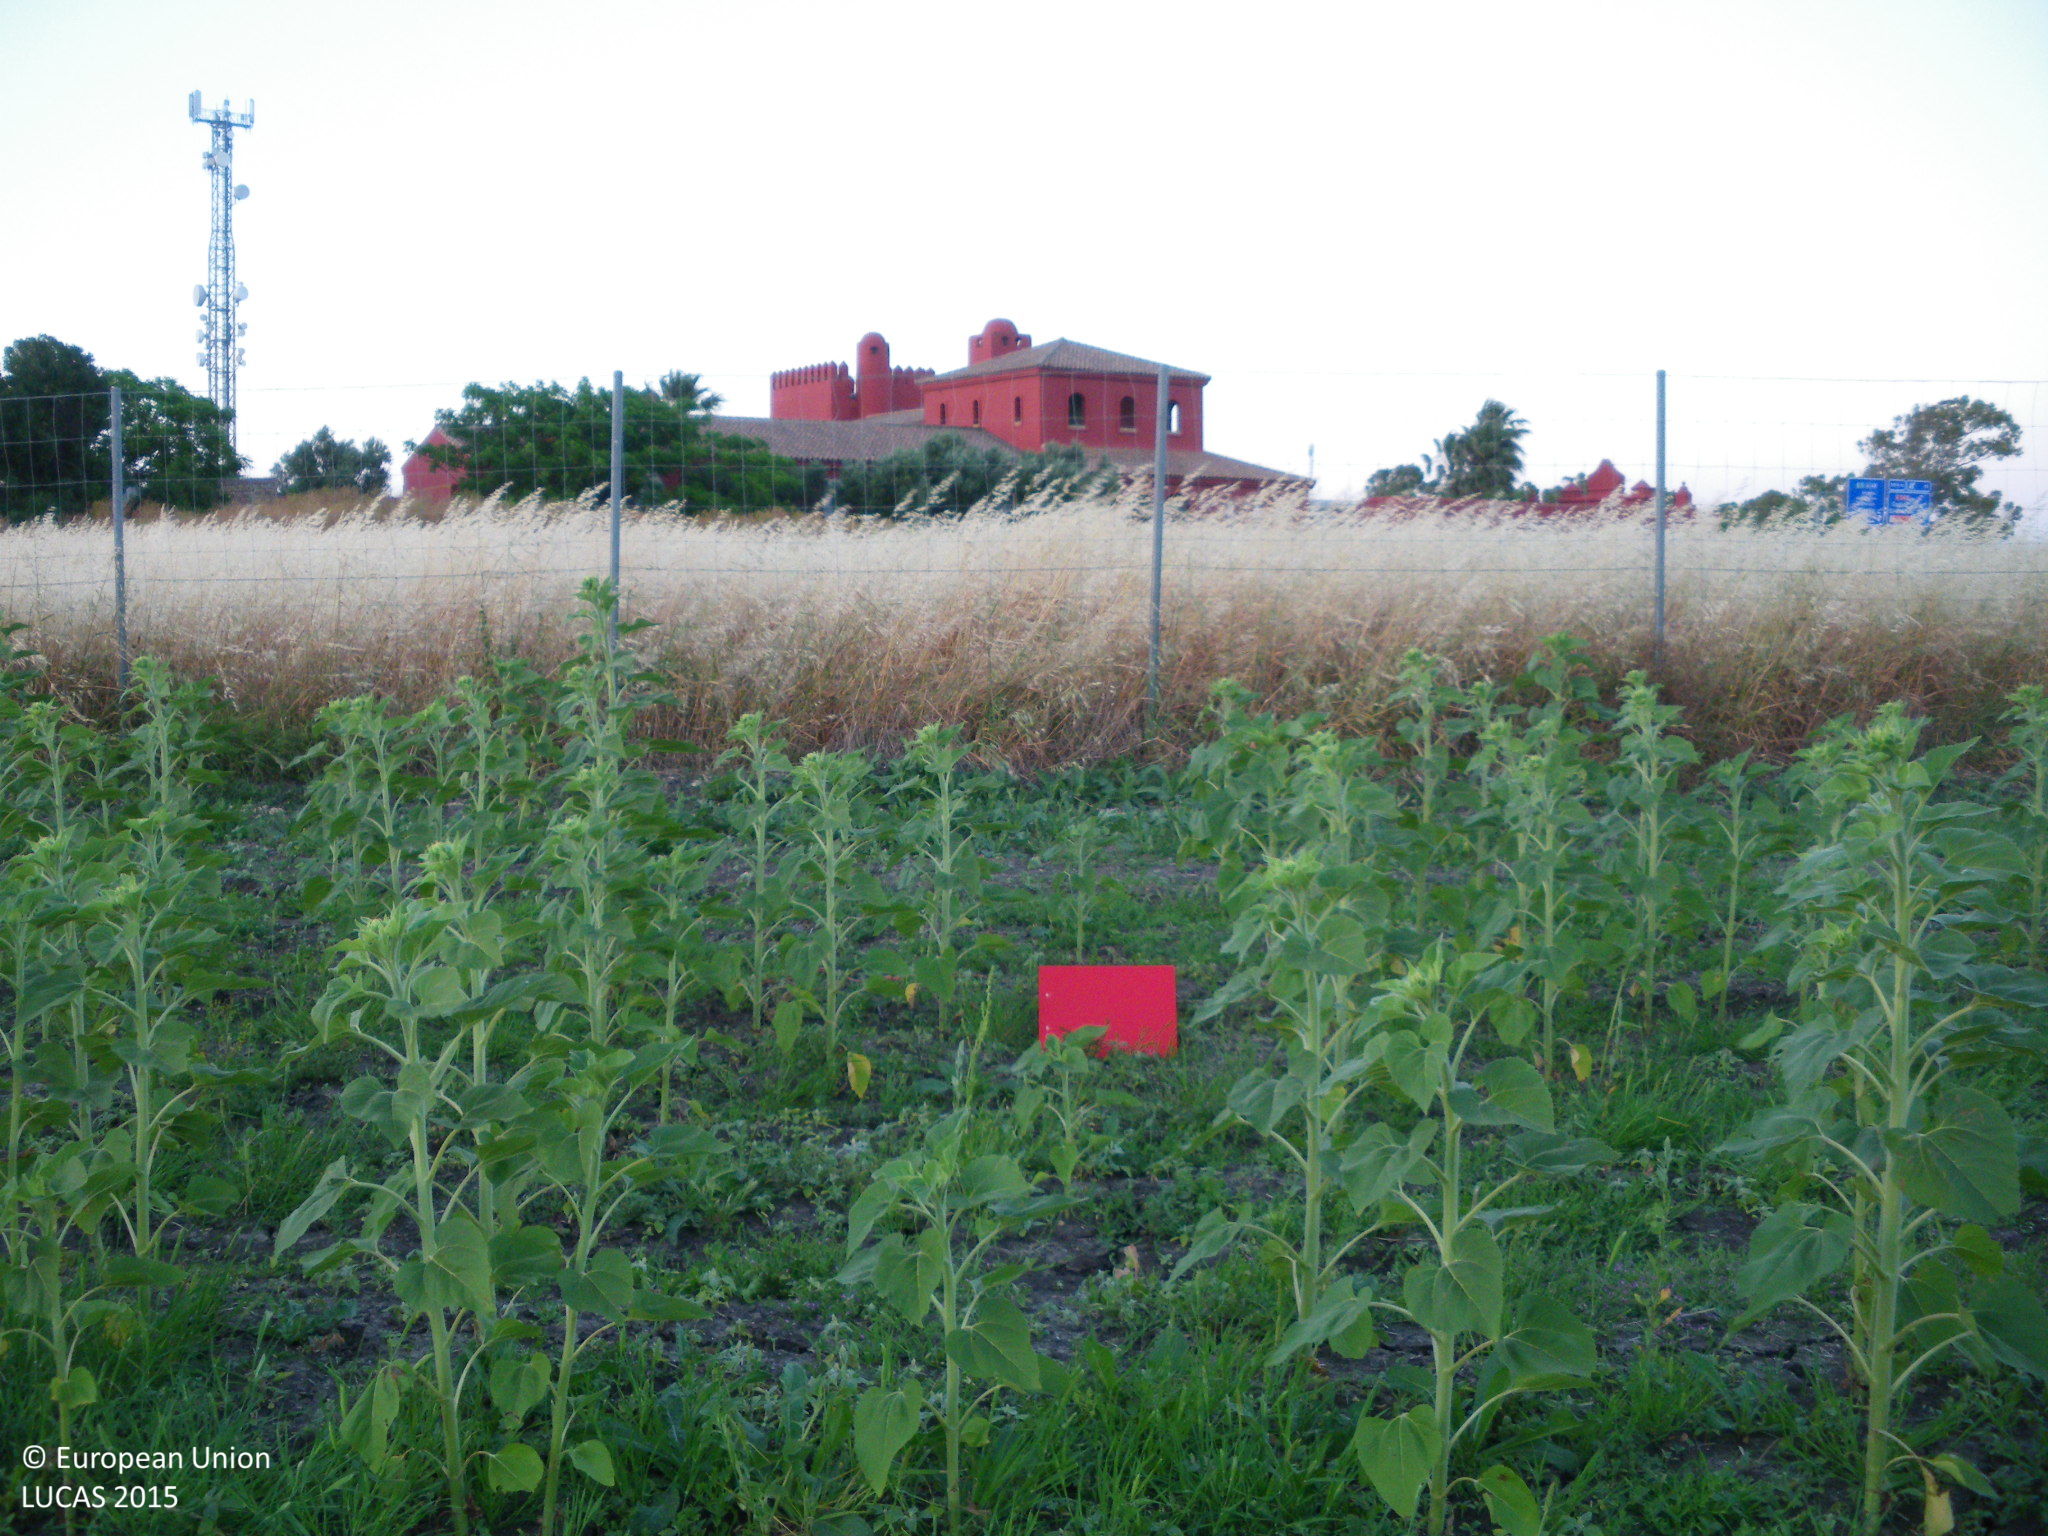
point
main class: Cropland
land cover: Sunflower
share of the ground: 25 - 50 %
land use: Agriculture (excluding fallow land and kitchen gardens)
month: May
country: ES
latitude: 36.3642
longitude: -6.1097
